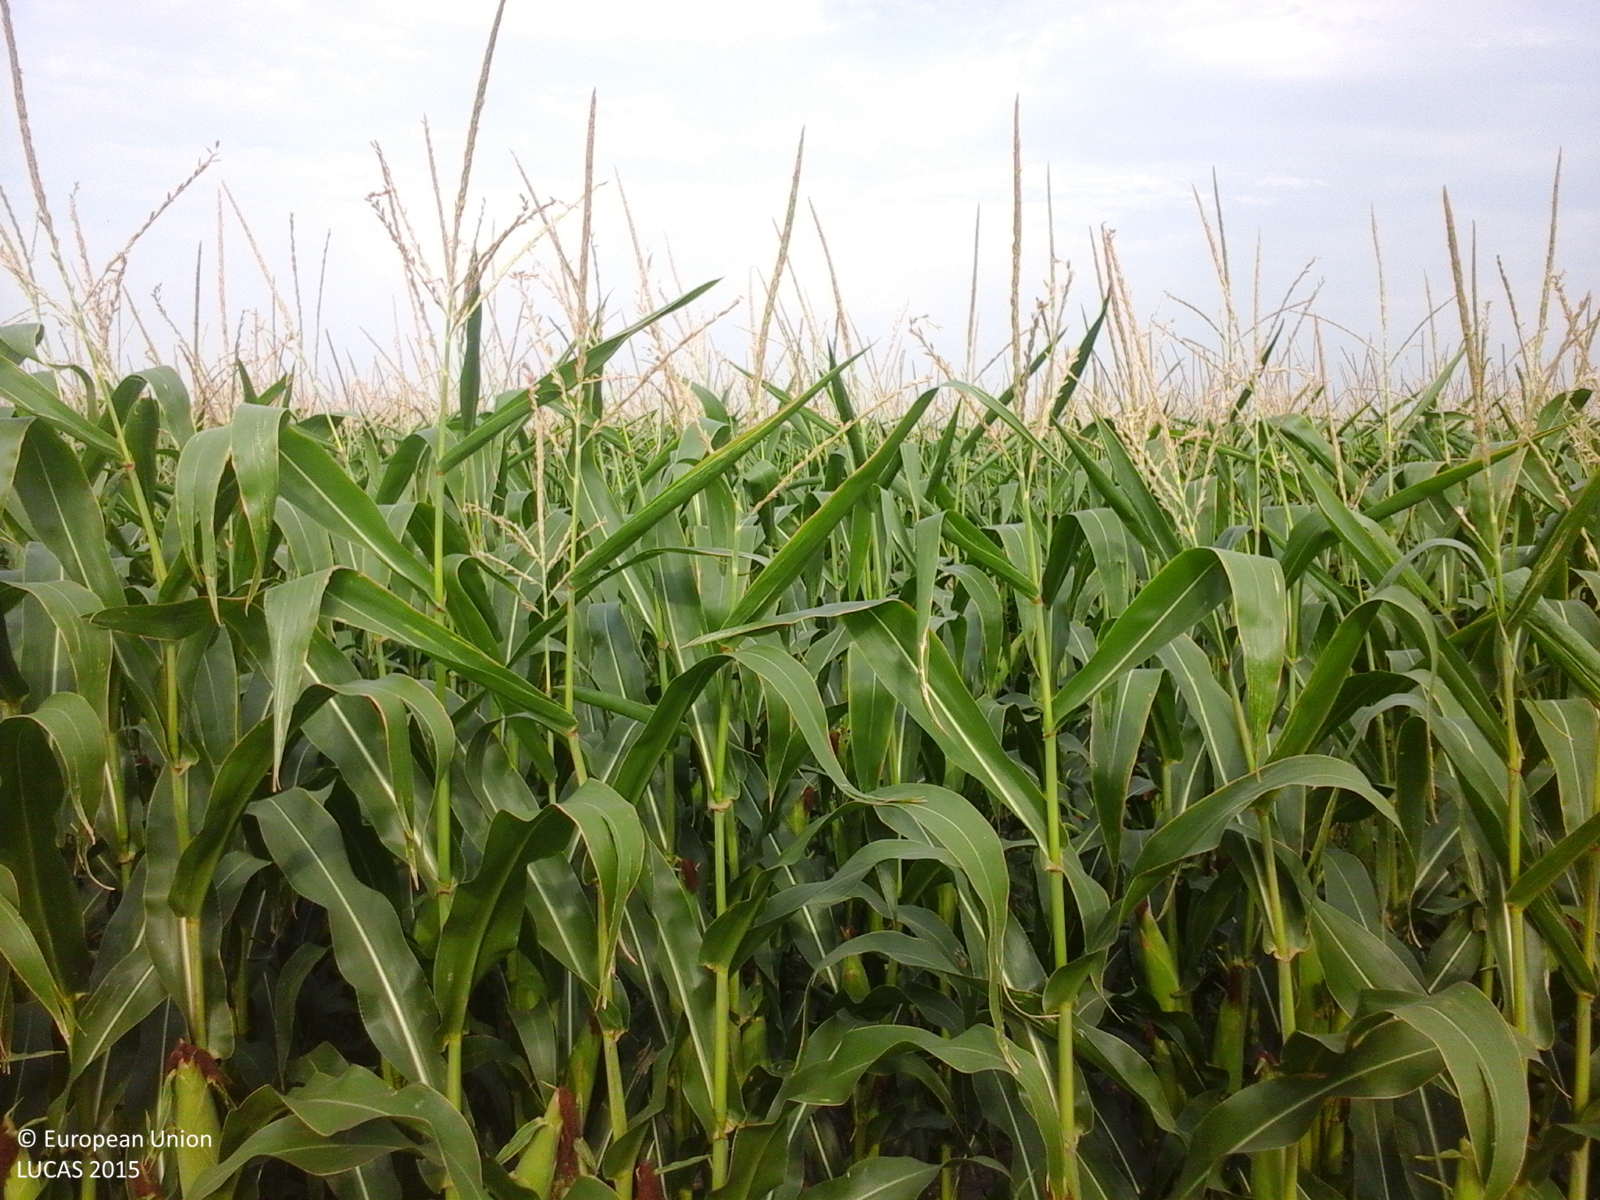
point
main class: Cropland
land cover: Maize
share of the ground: > 75 %
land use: Agriculture (excluding fallow land and kitchen gardens)
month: August
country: RO
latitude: 45.0504
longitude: 27.6629
